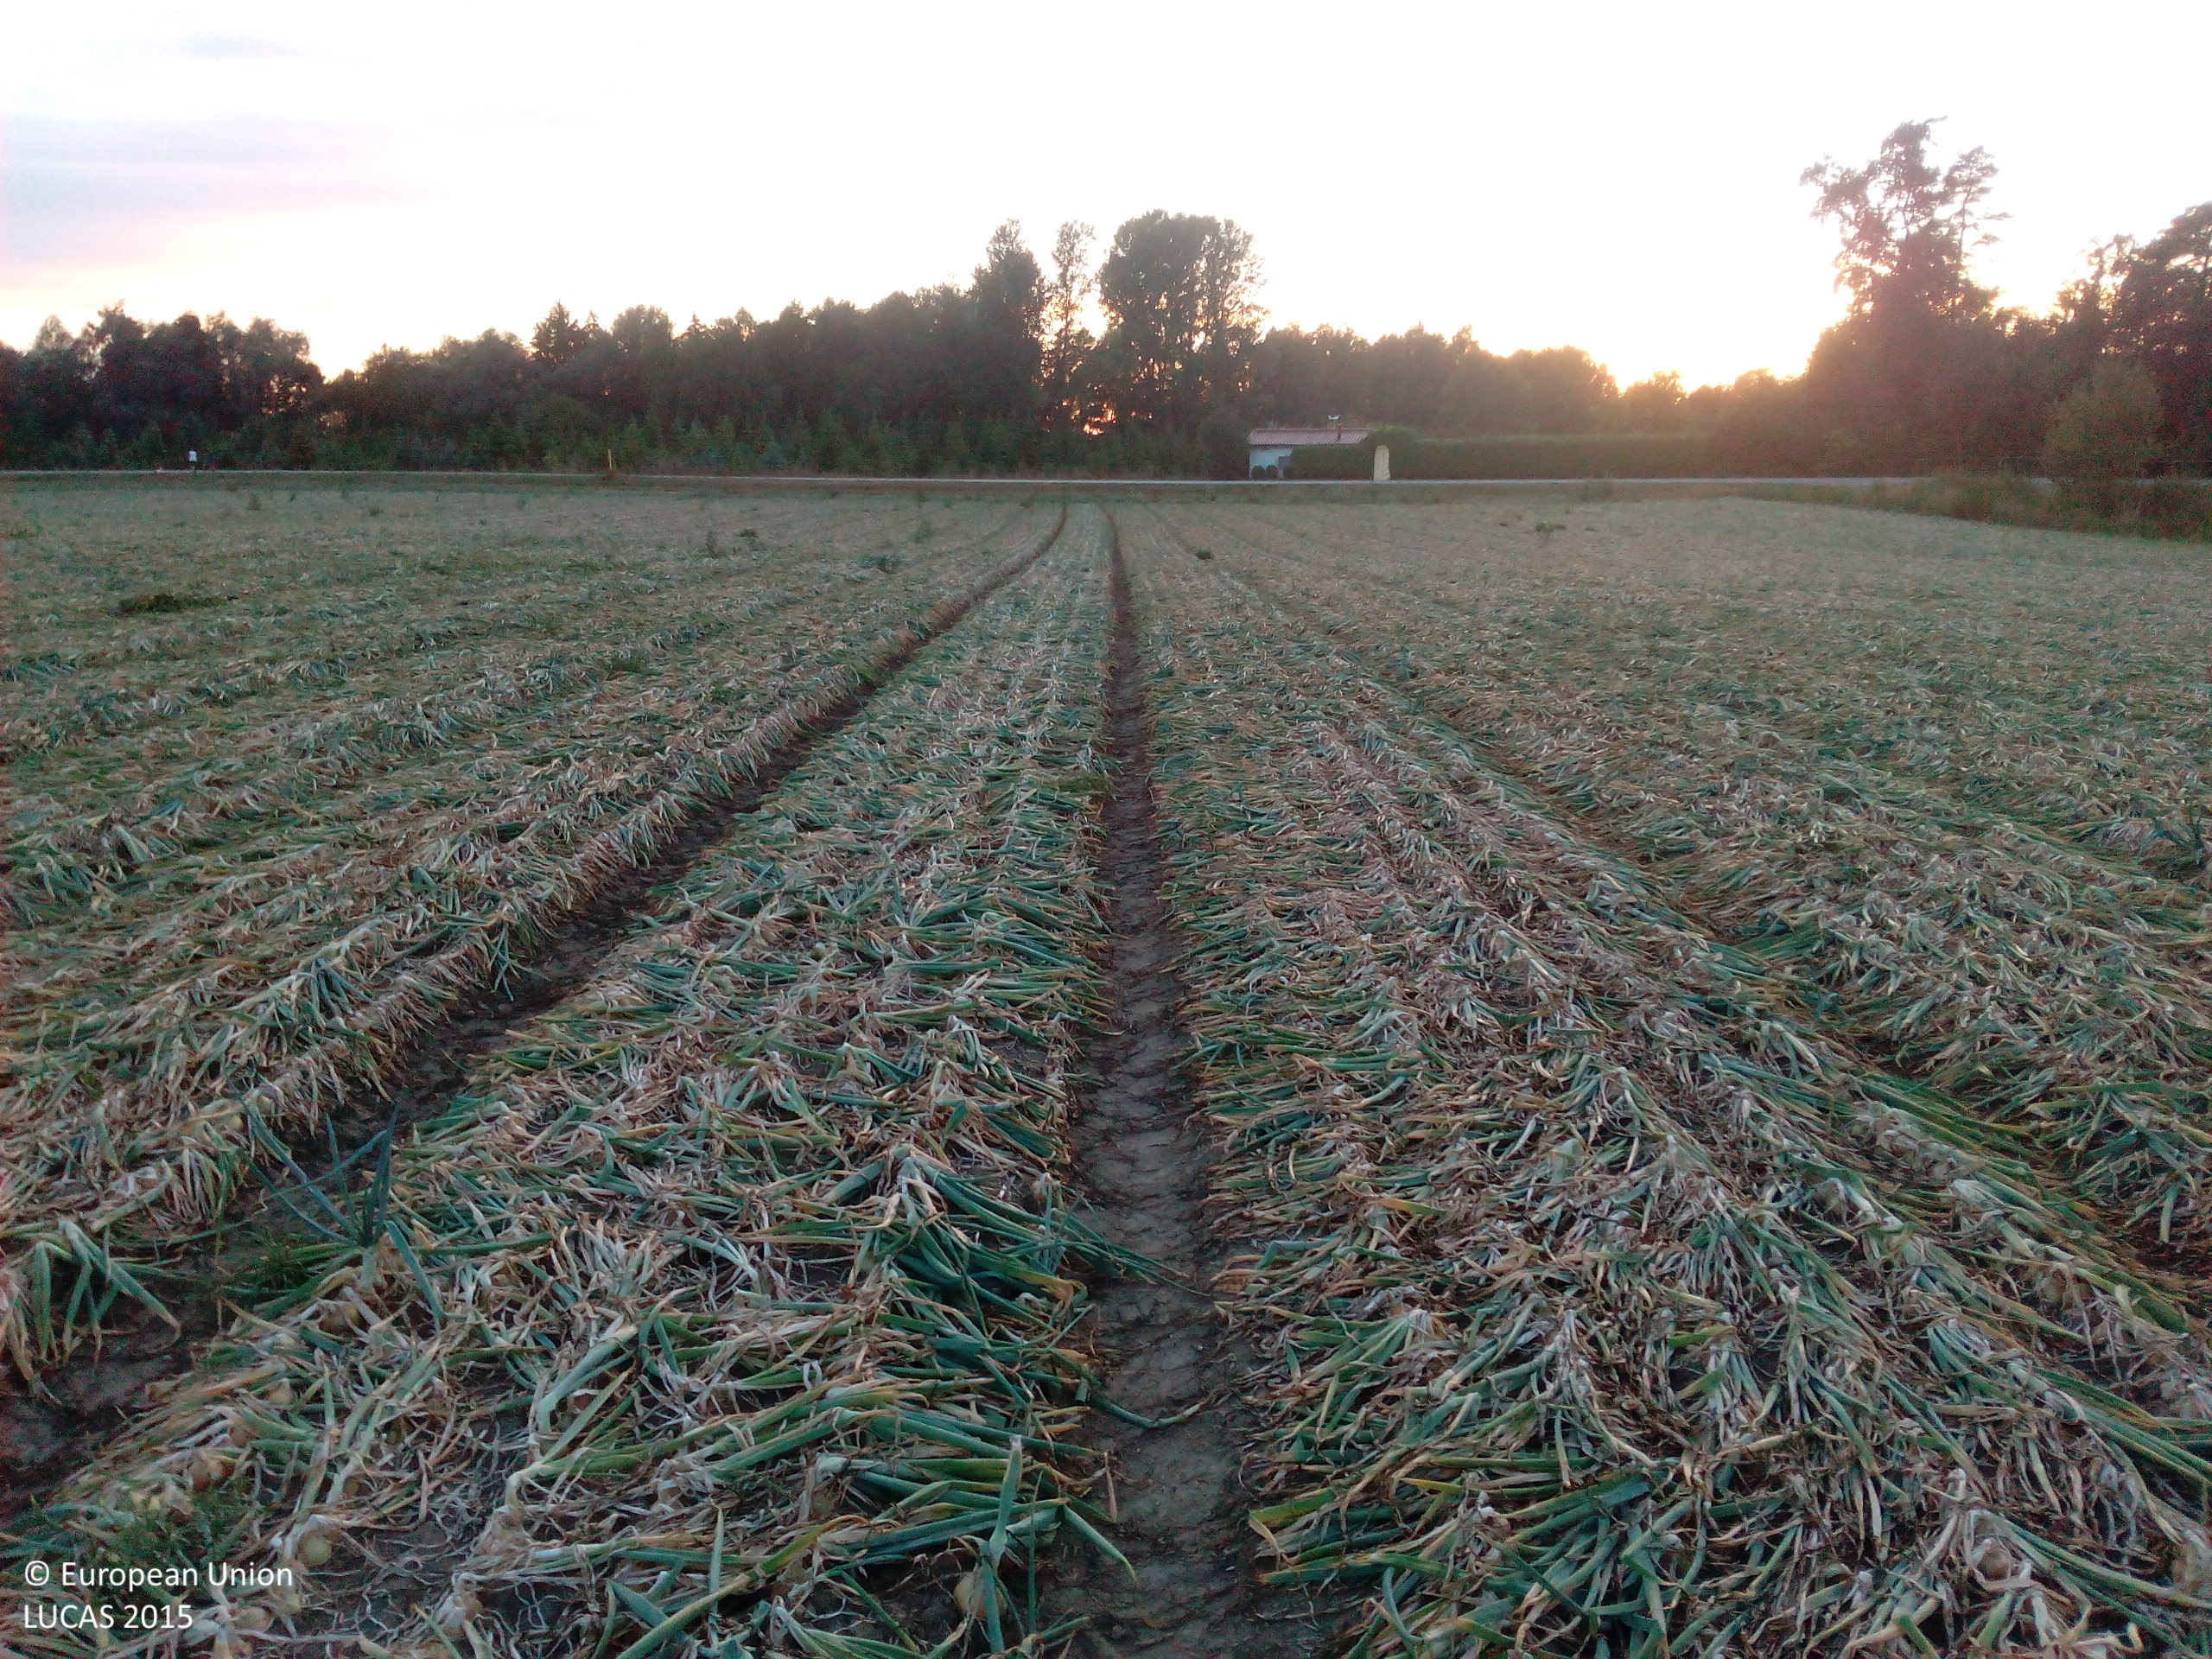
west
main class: Cropland
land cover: Other root crops
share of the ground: 50 - 75 %
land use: Agriculture (excluding fallow land and kitchen gardens)
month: August
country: DE
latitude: 48.7609
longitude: 12.9242
